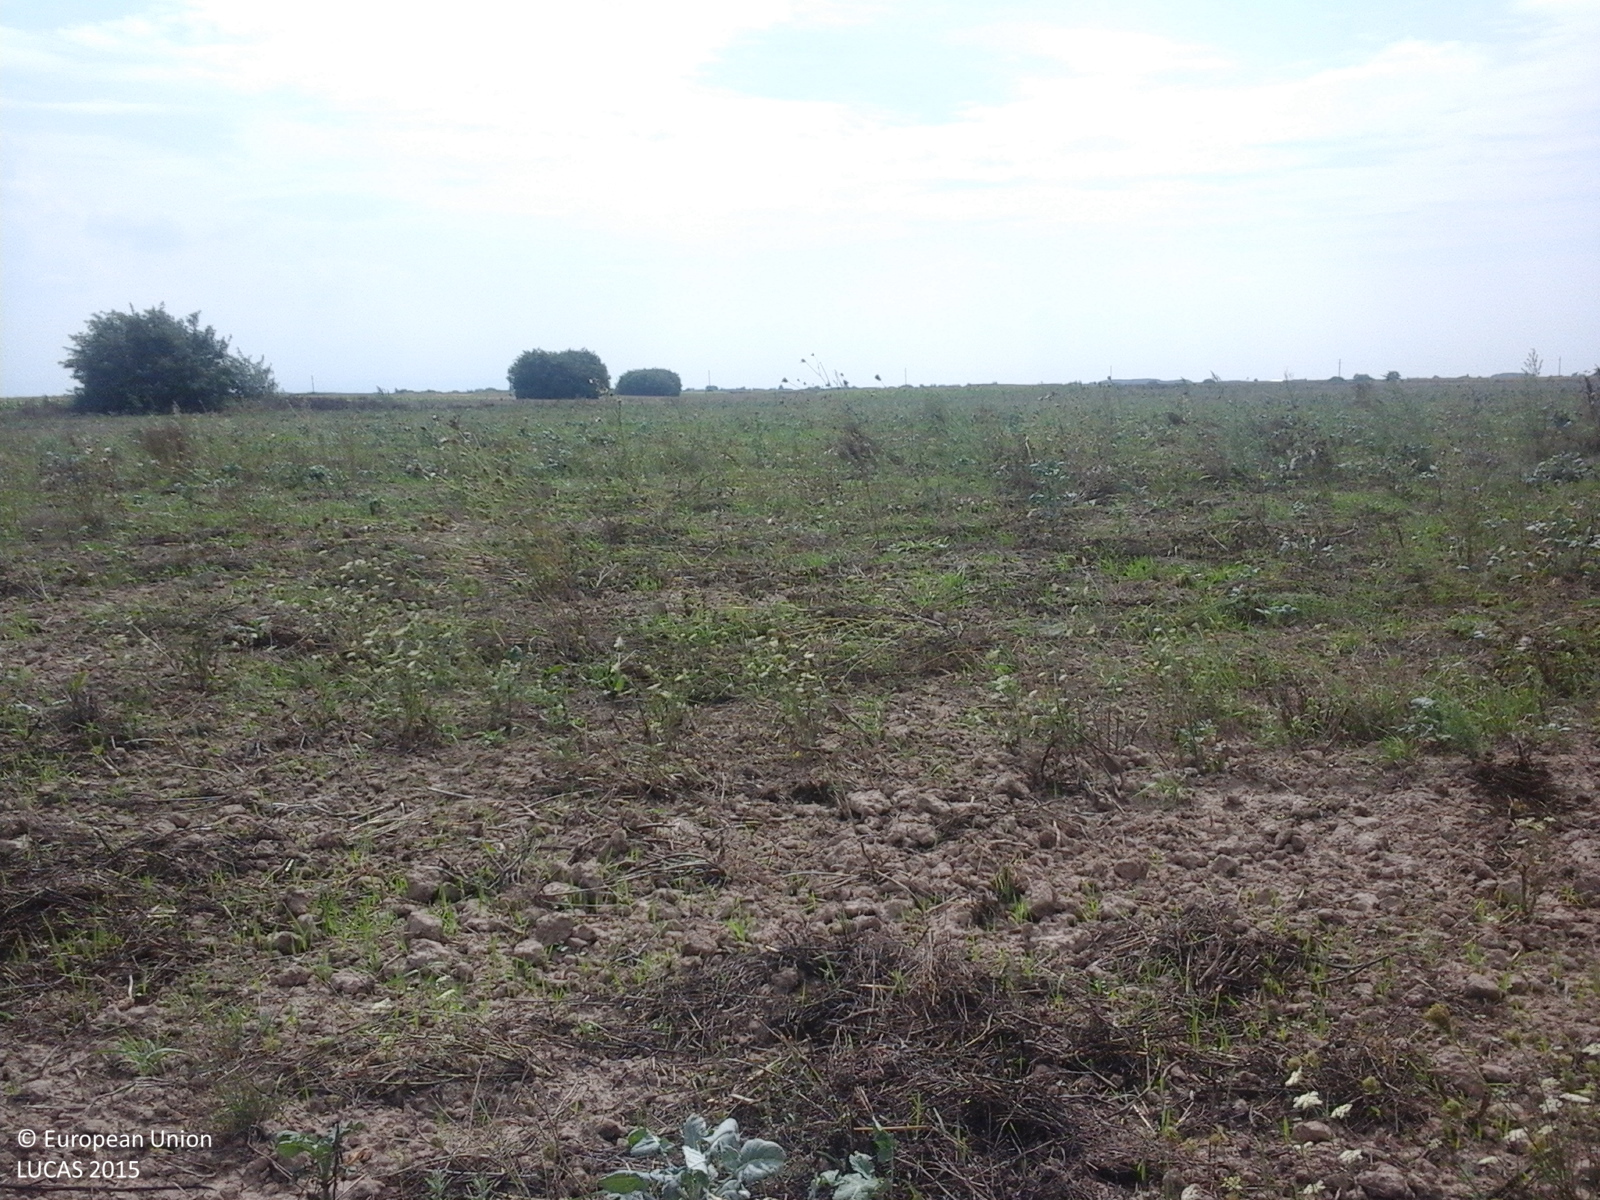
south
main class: Grassland
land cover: Spontaneously vegetated surfaces
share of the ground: 25 - 50 %
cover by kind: herbaceous plants 100 %
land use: Fallow land
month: August
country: RO
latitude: 46.5720
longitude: 21.7713
